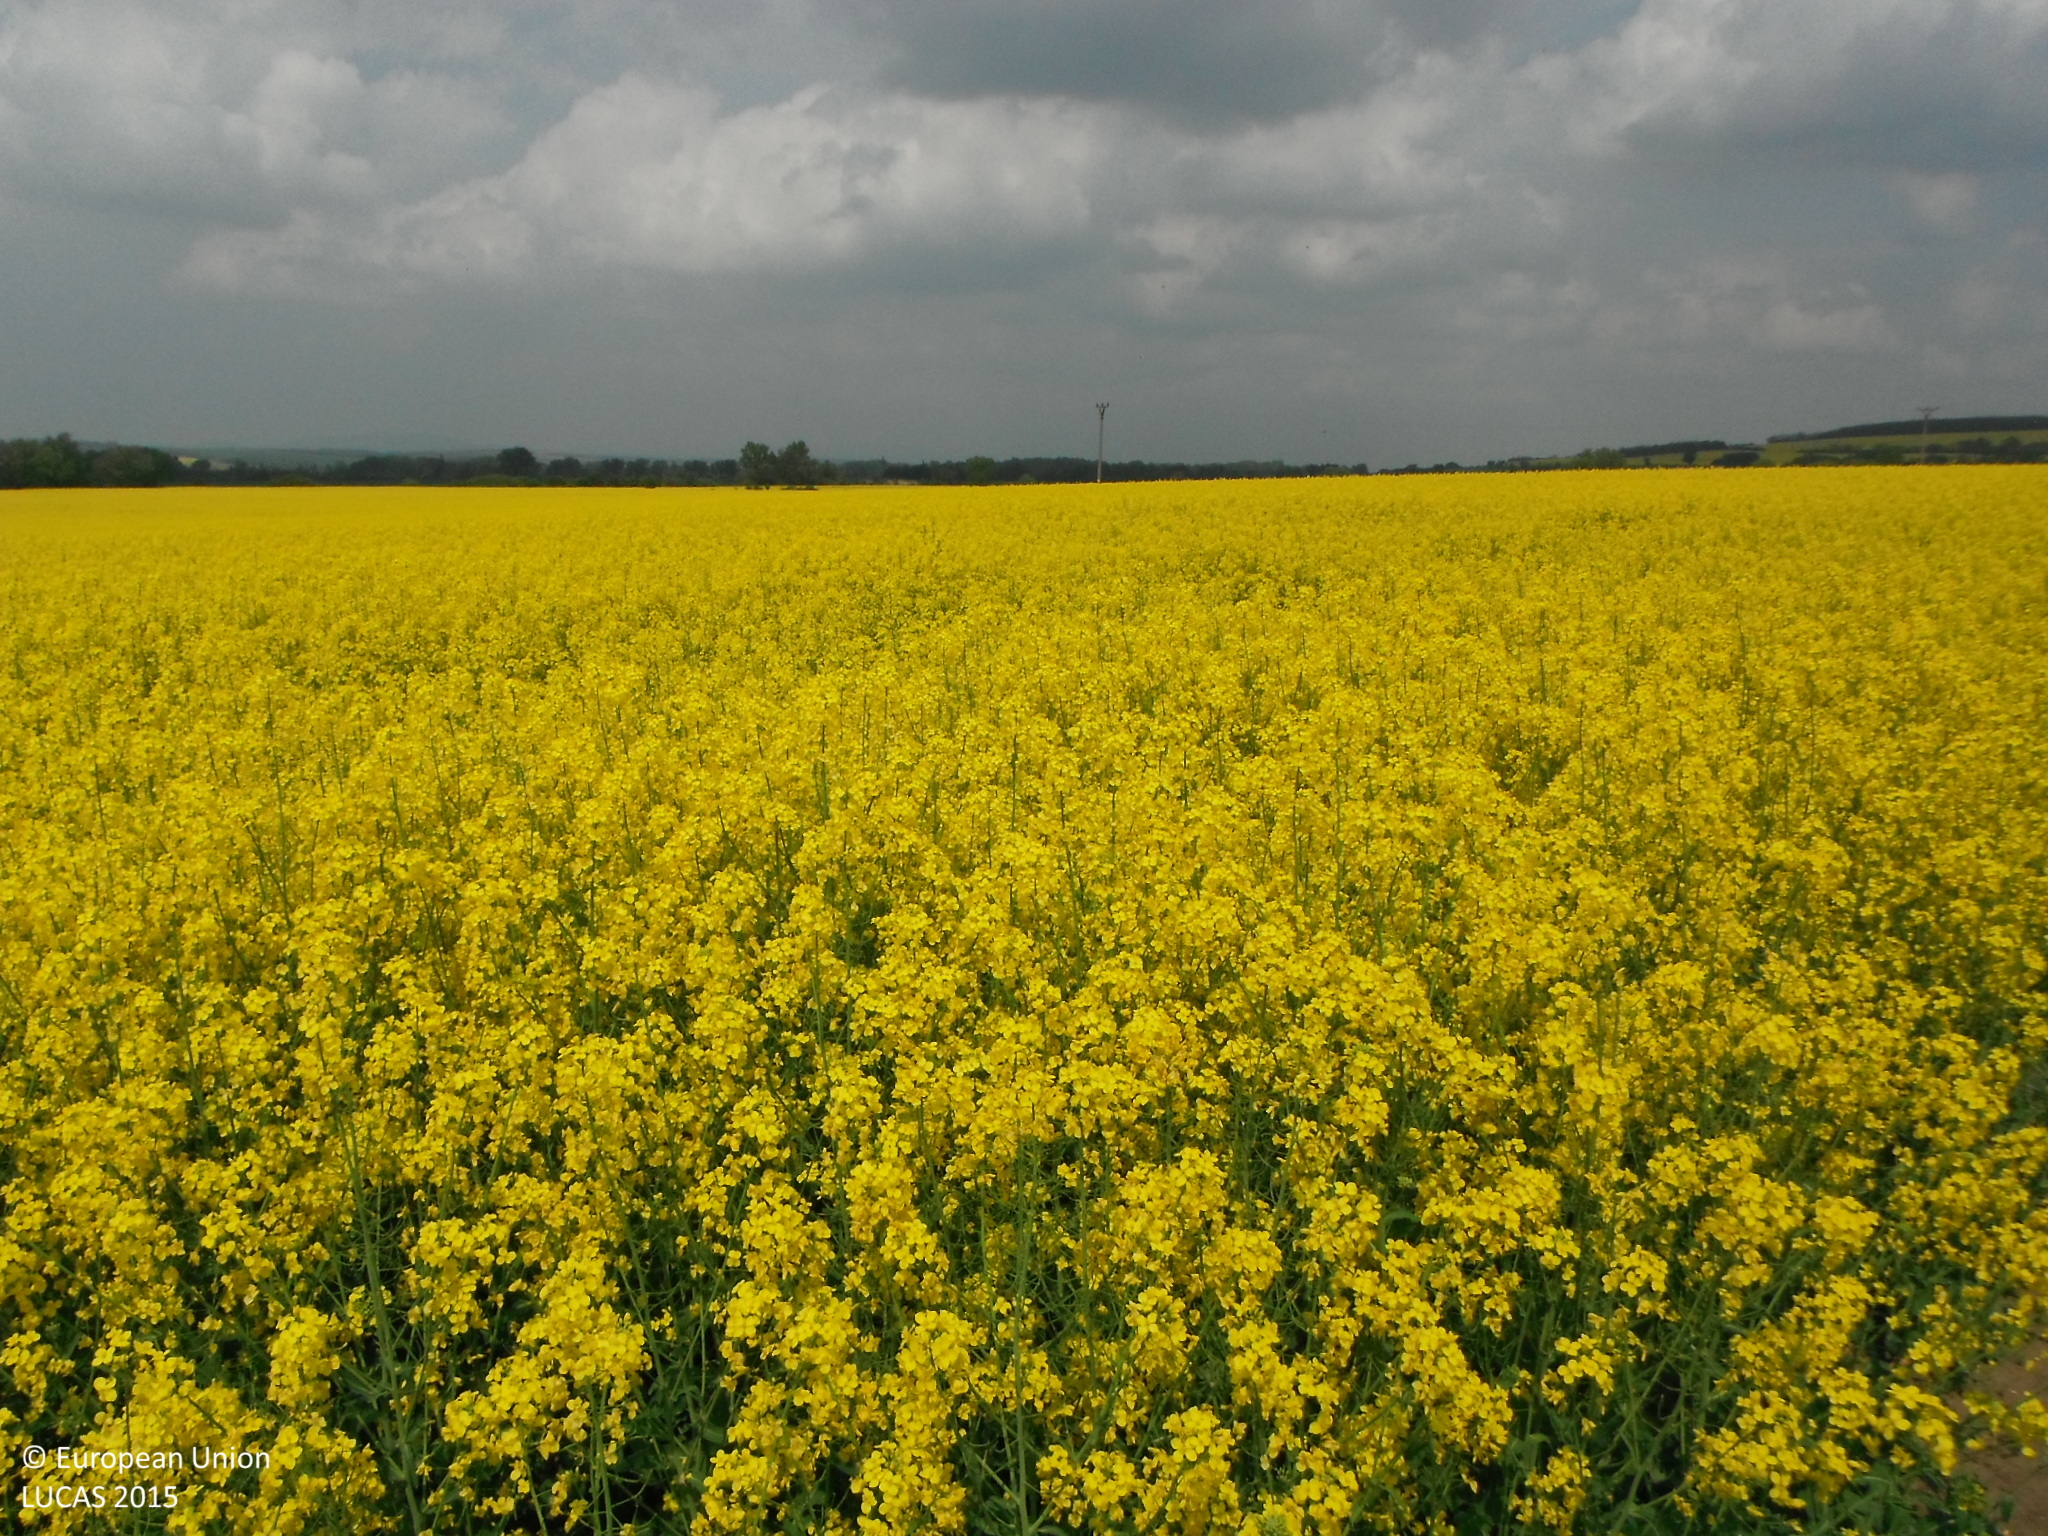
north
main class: Cropland
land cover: Rape and turnip rape
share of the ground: > 75 %
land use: Agriculture (excluding fallow land and kitchen gardens)
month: May
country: SK
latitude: 48.3950
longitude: 18.1039
